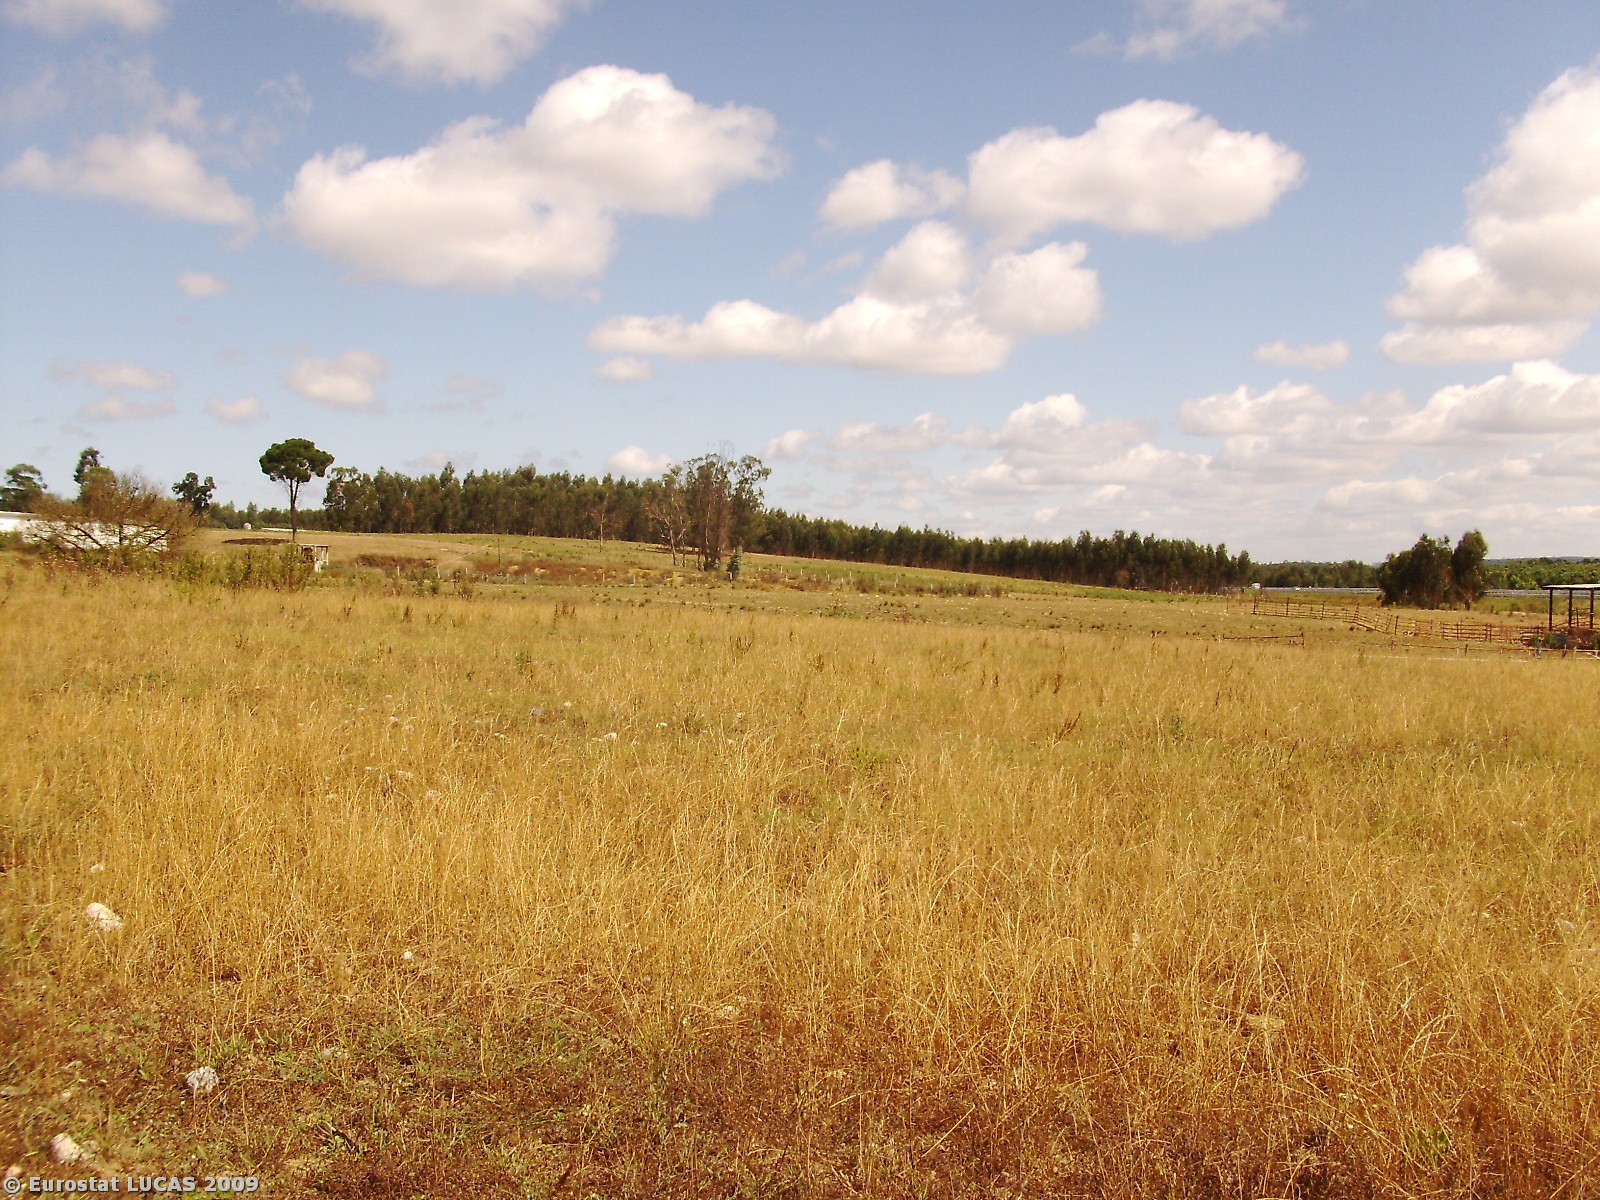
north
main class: Grassland
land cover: Spontaneously vegetated surfaces
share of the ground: > 75 %
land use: Fallow land
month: July
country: PT
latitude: 39.7688
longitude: -8.8717
